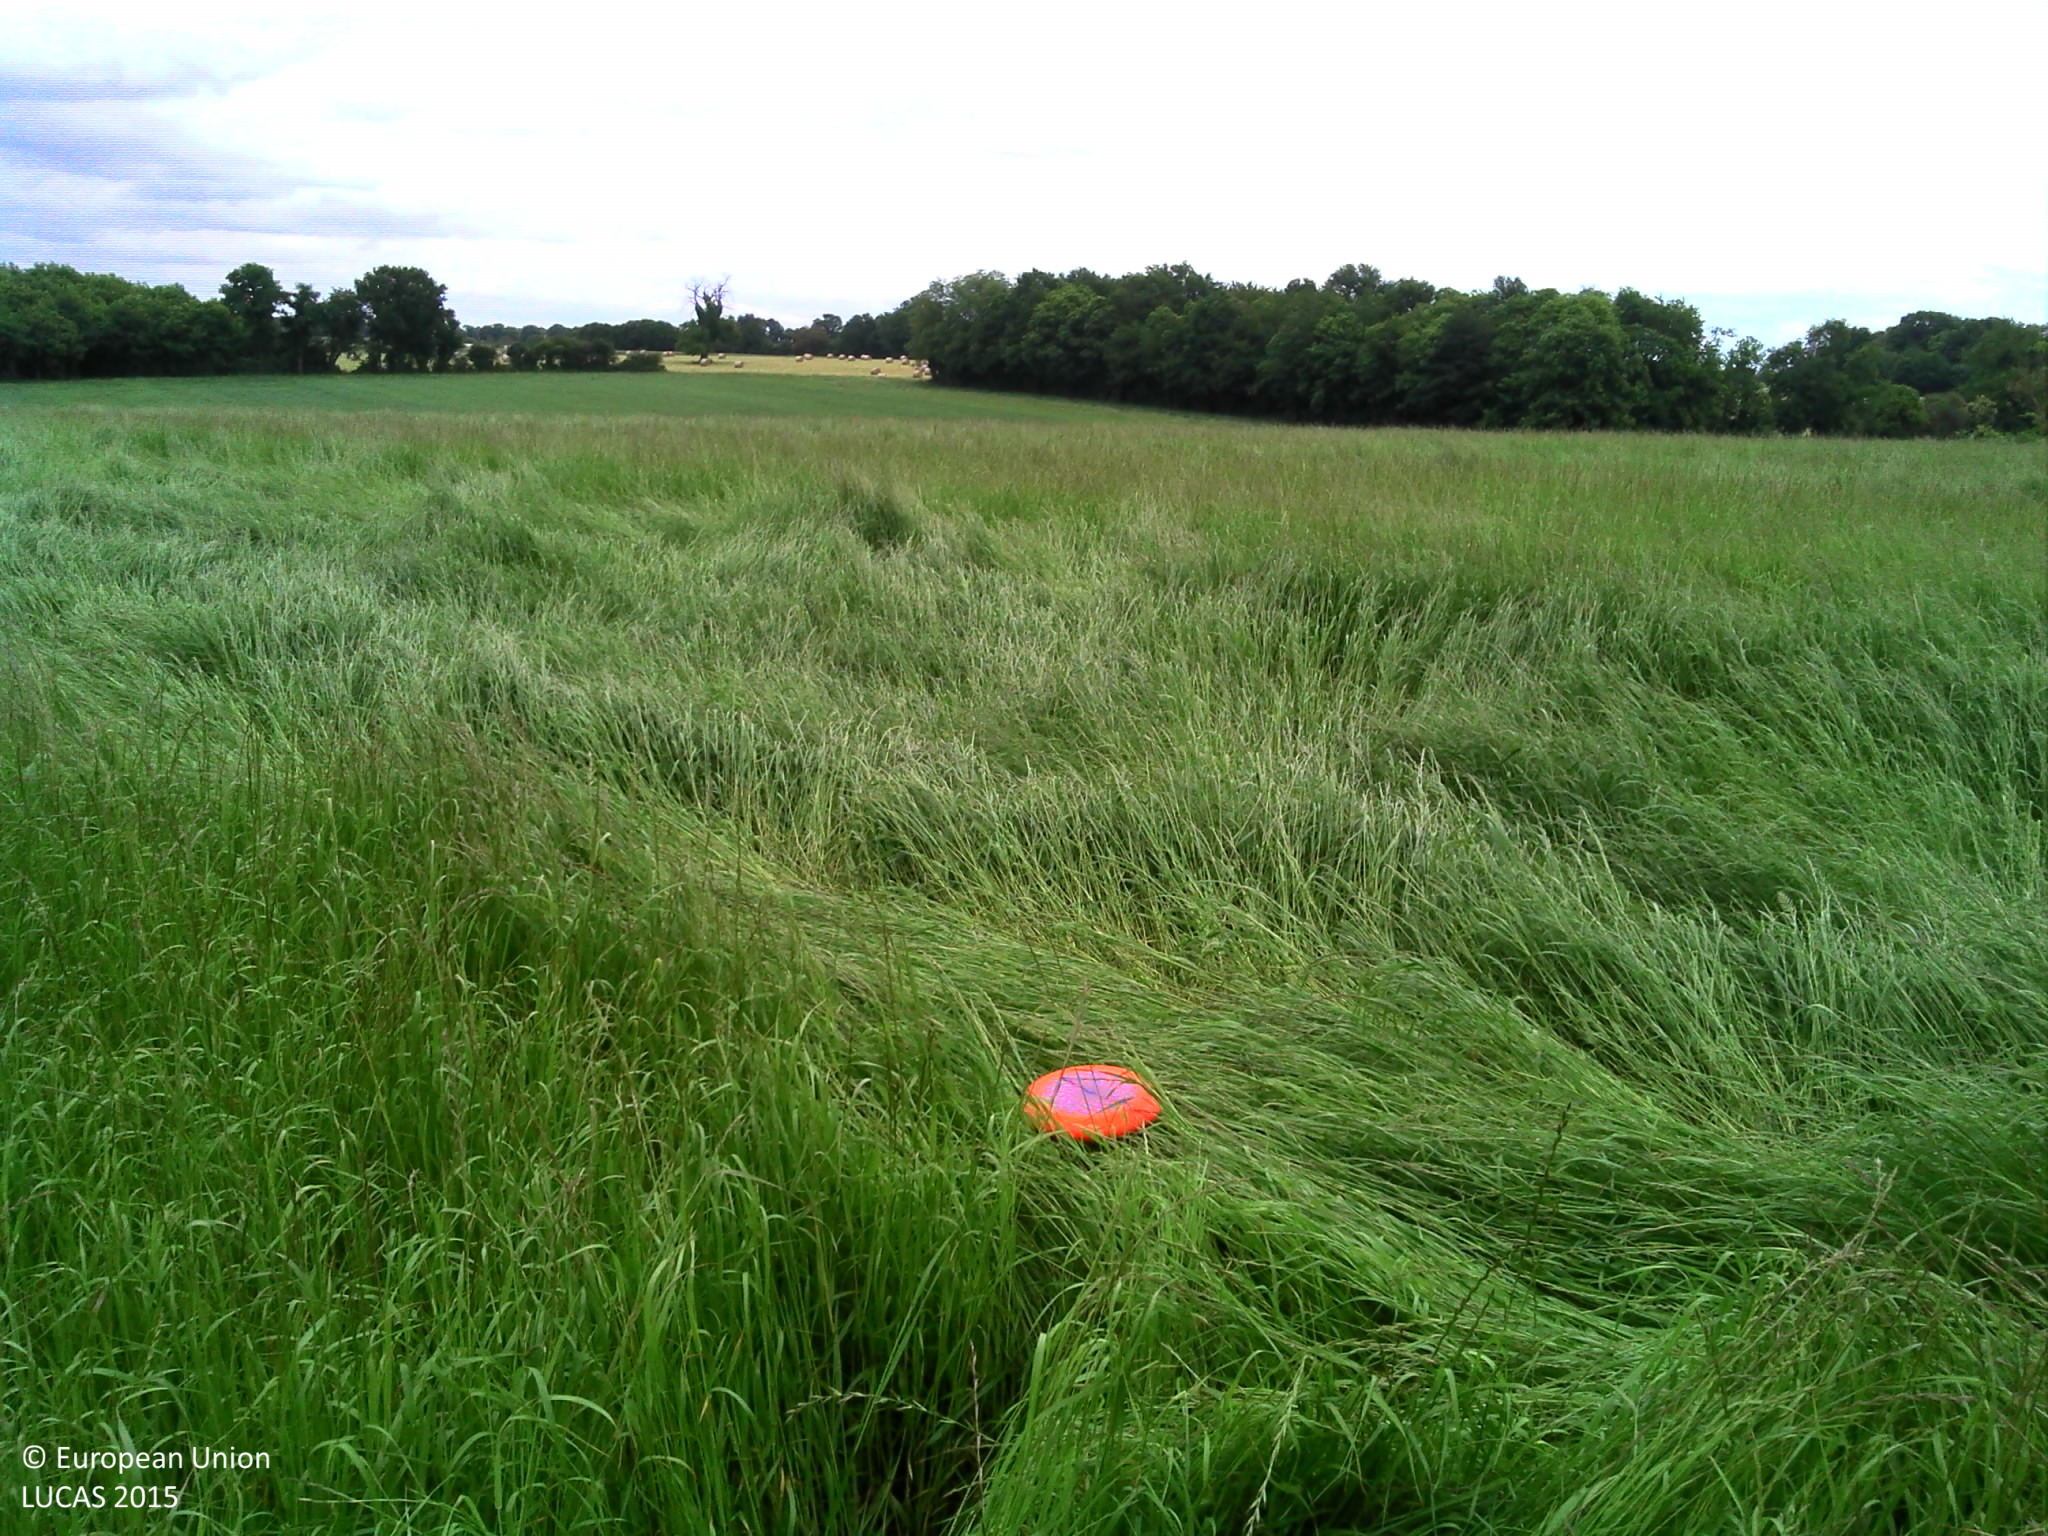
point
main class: Cropland
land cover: Temporary grasslands
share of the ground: > 75 %
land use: Agriculture (excluding fallow land and kitchen gardens)
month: June
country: FR
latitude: 46.0415
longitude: 0.3564
